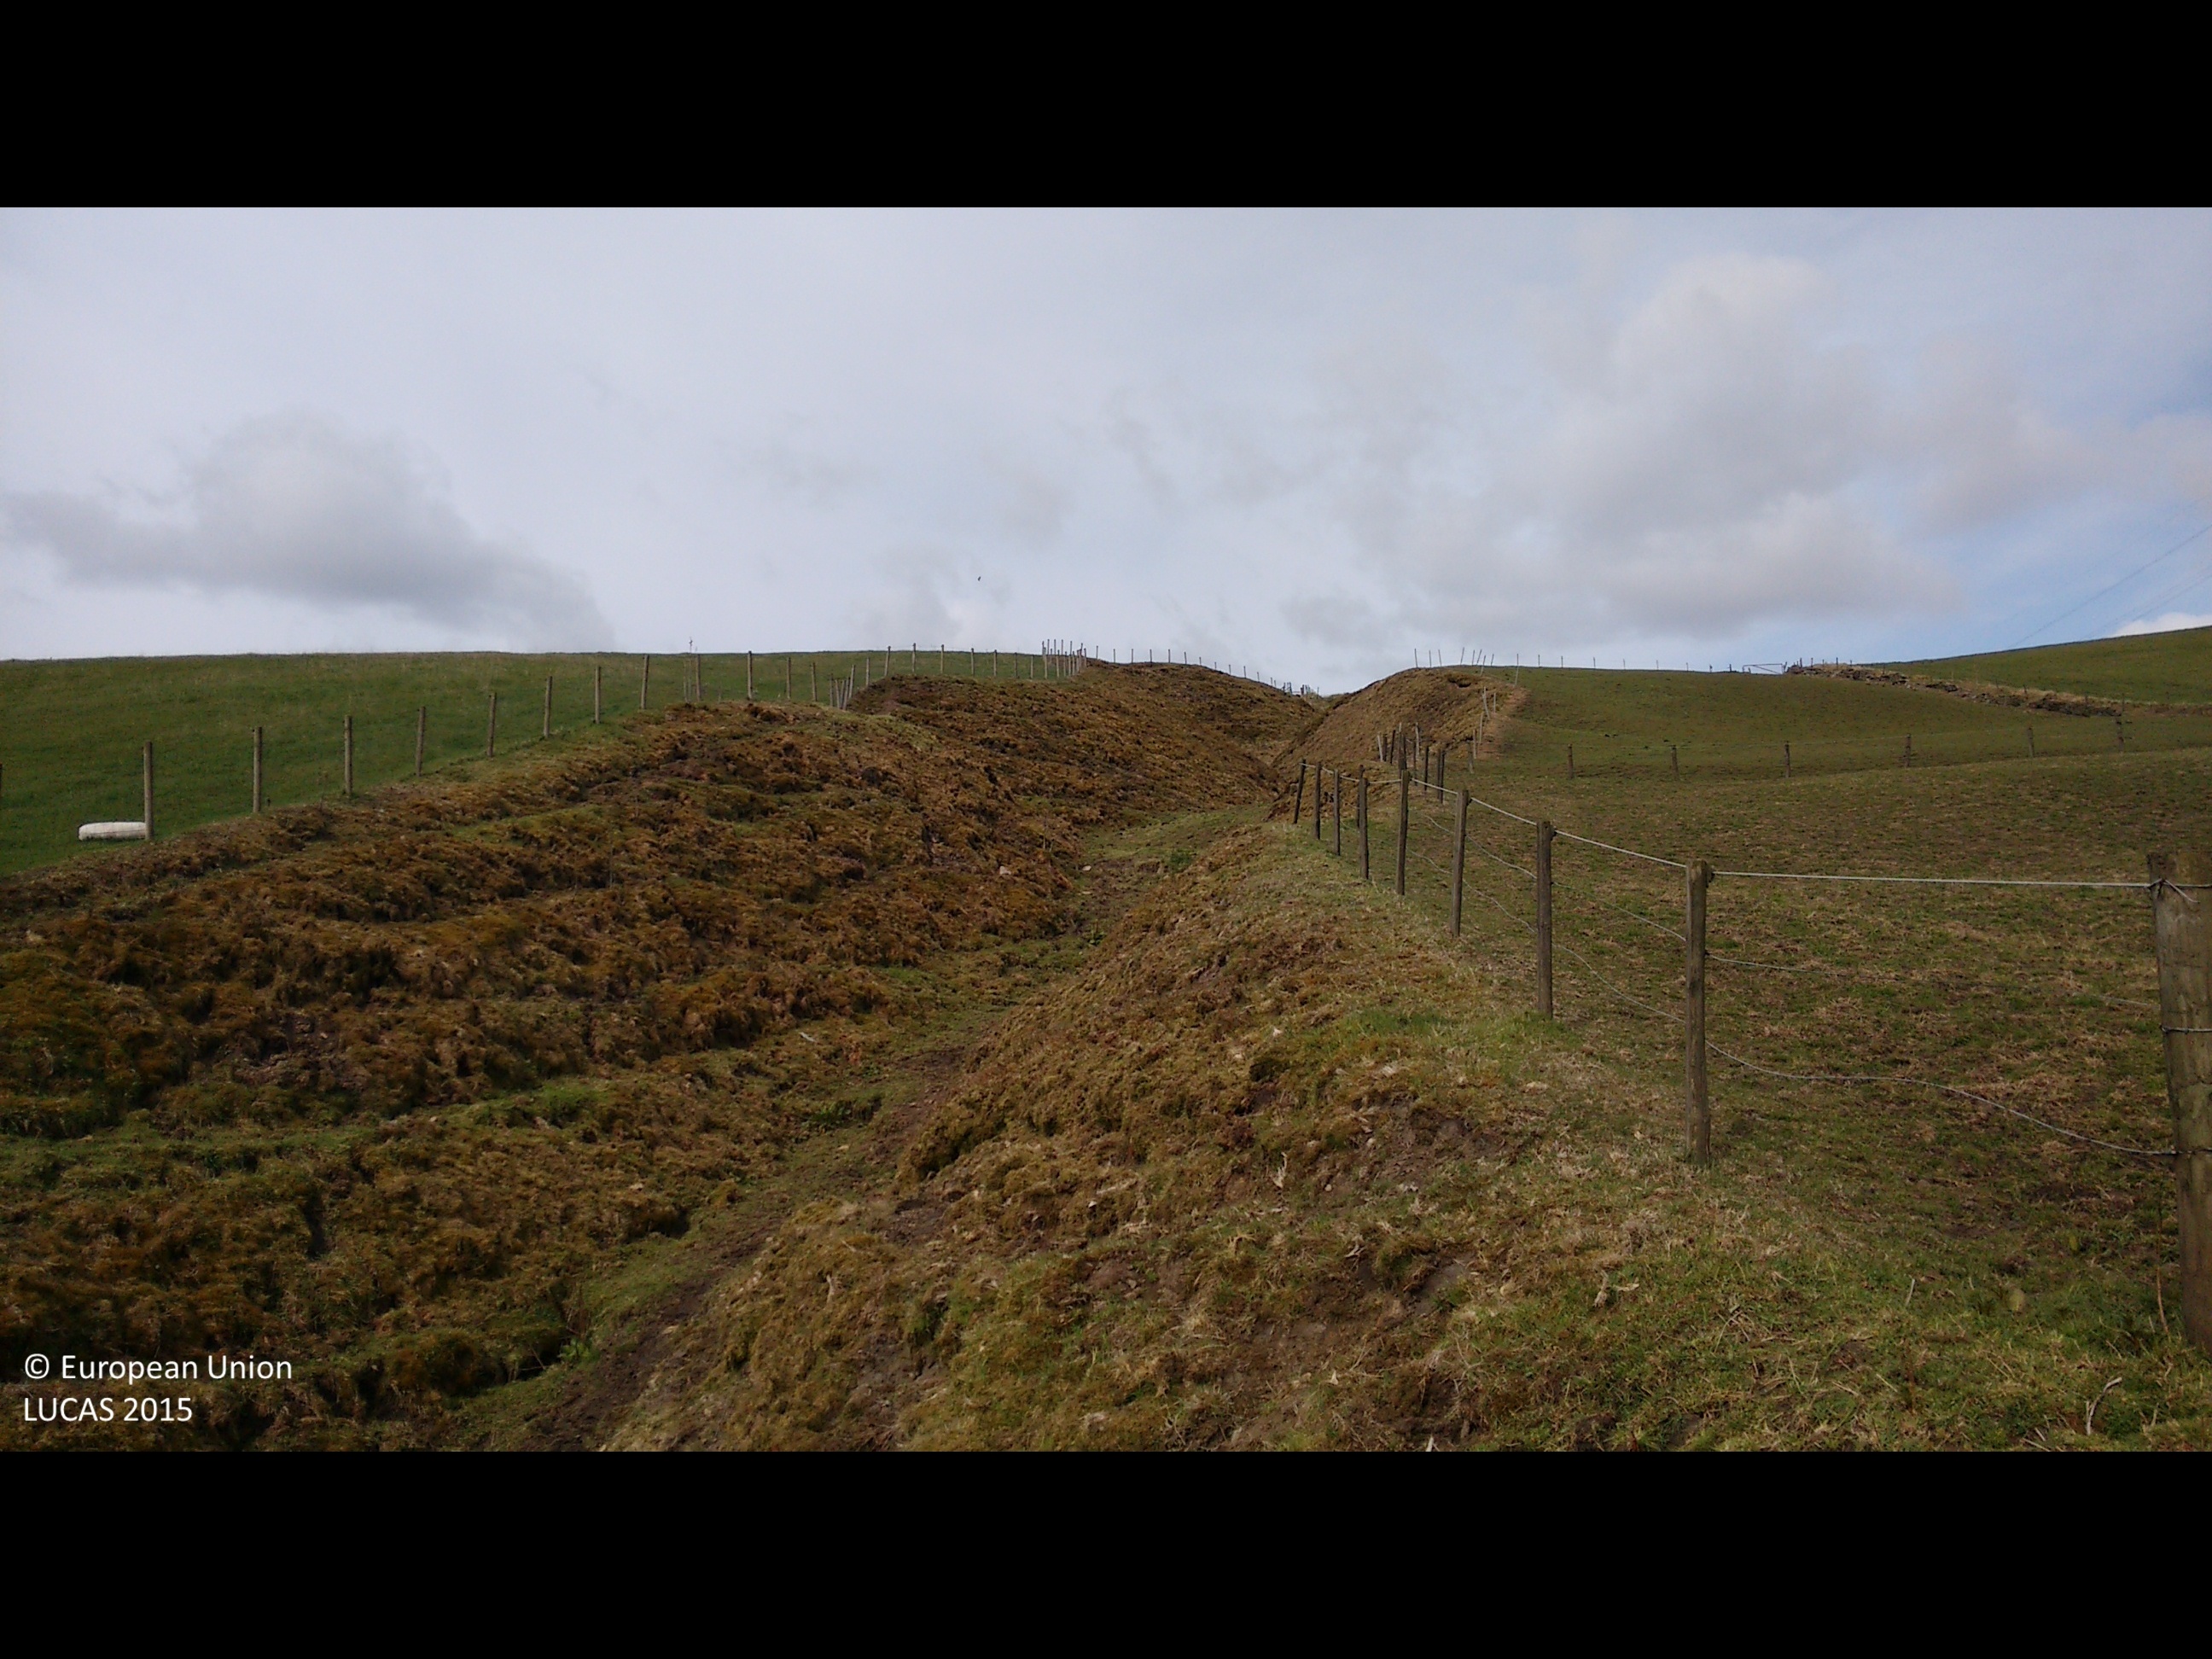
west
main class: Grassland
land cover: Grassland without tree/shrub cover
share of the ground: > 75 %
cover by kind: herbaceous plants 100 %
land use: Agriculture (excluding fallow land and kitchen gardens)
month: May
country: GB
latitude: 53.7282
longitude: -2.2011
